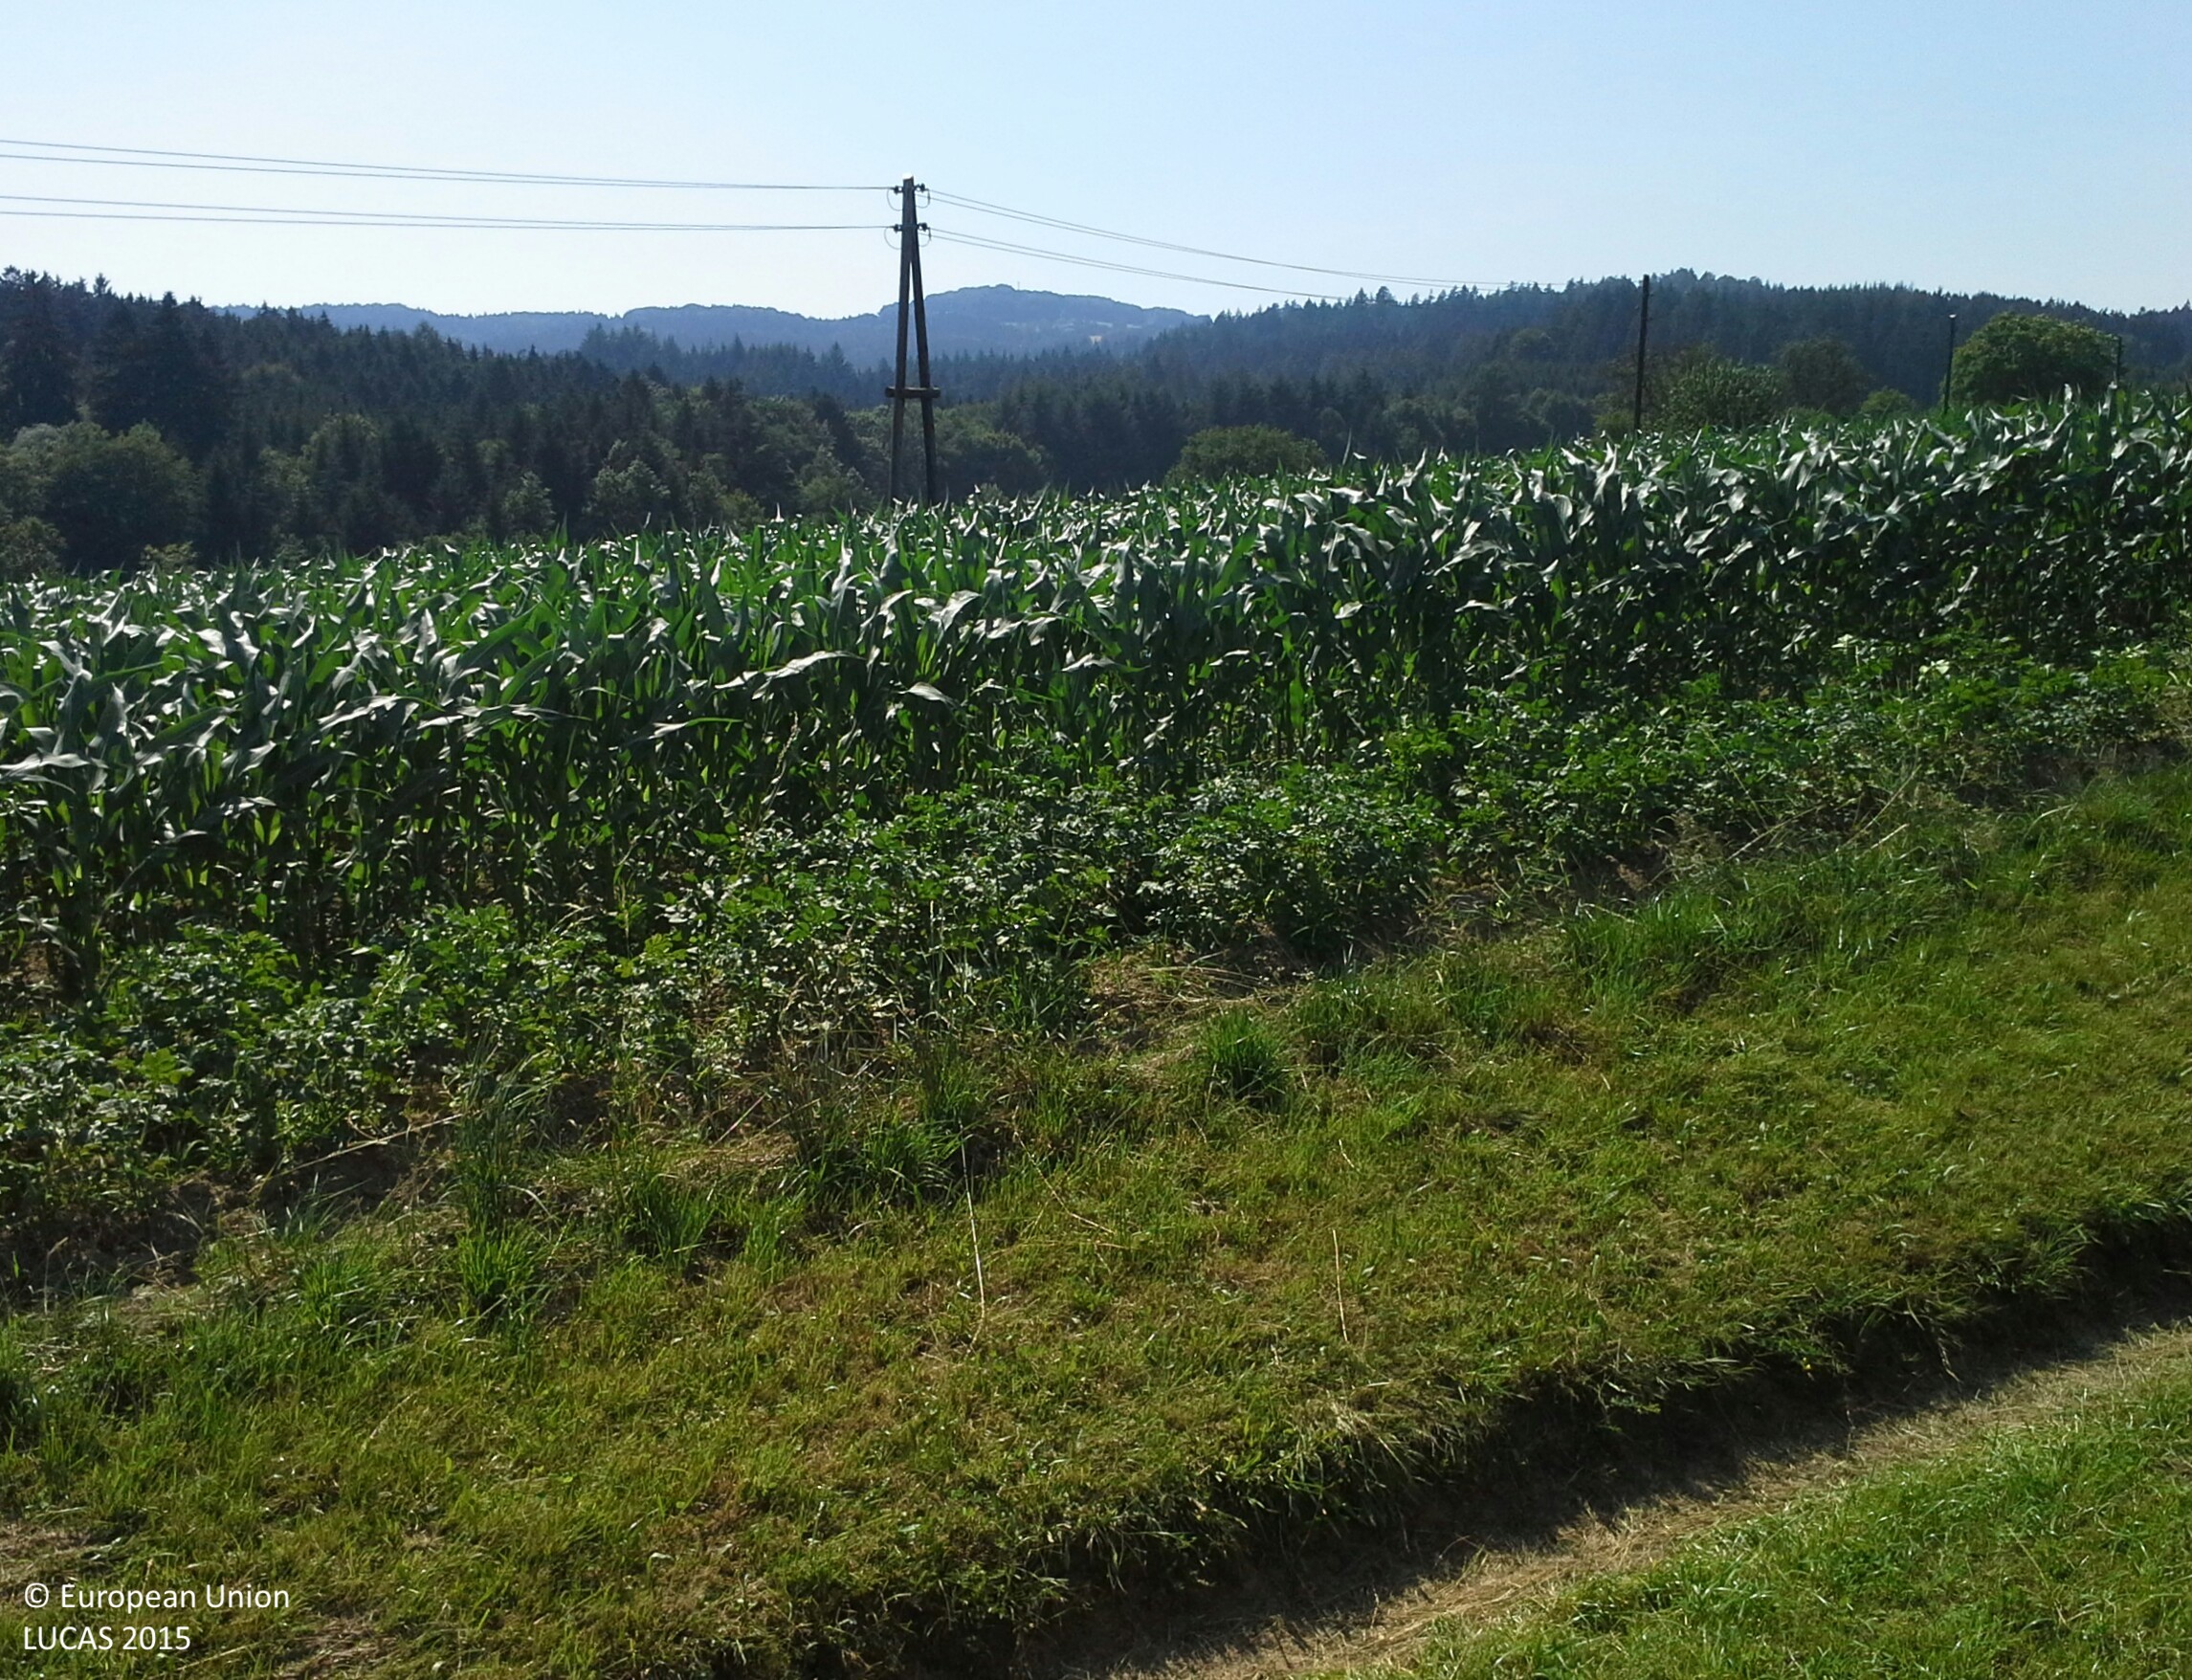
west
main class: Grassland
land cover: Grassland without tree/shrub cover
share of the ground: > 75 %
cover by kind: herbaceous plants 100 %
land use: Agriculture (excluding fallow land and kitchen gardens)
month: July
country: AT
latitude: 48.1802
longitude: 15.0448
